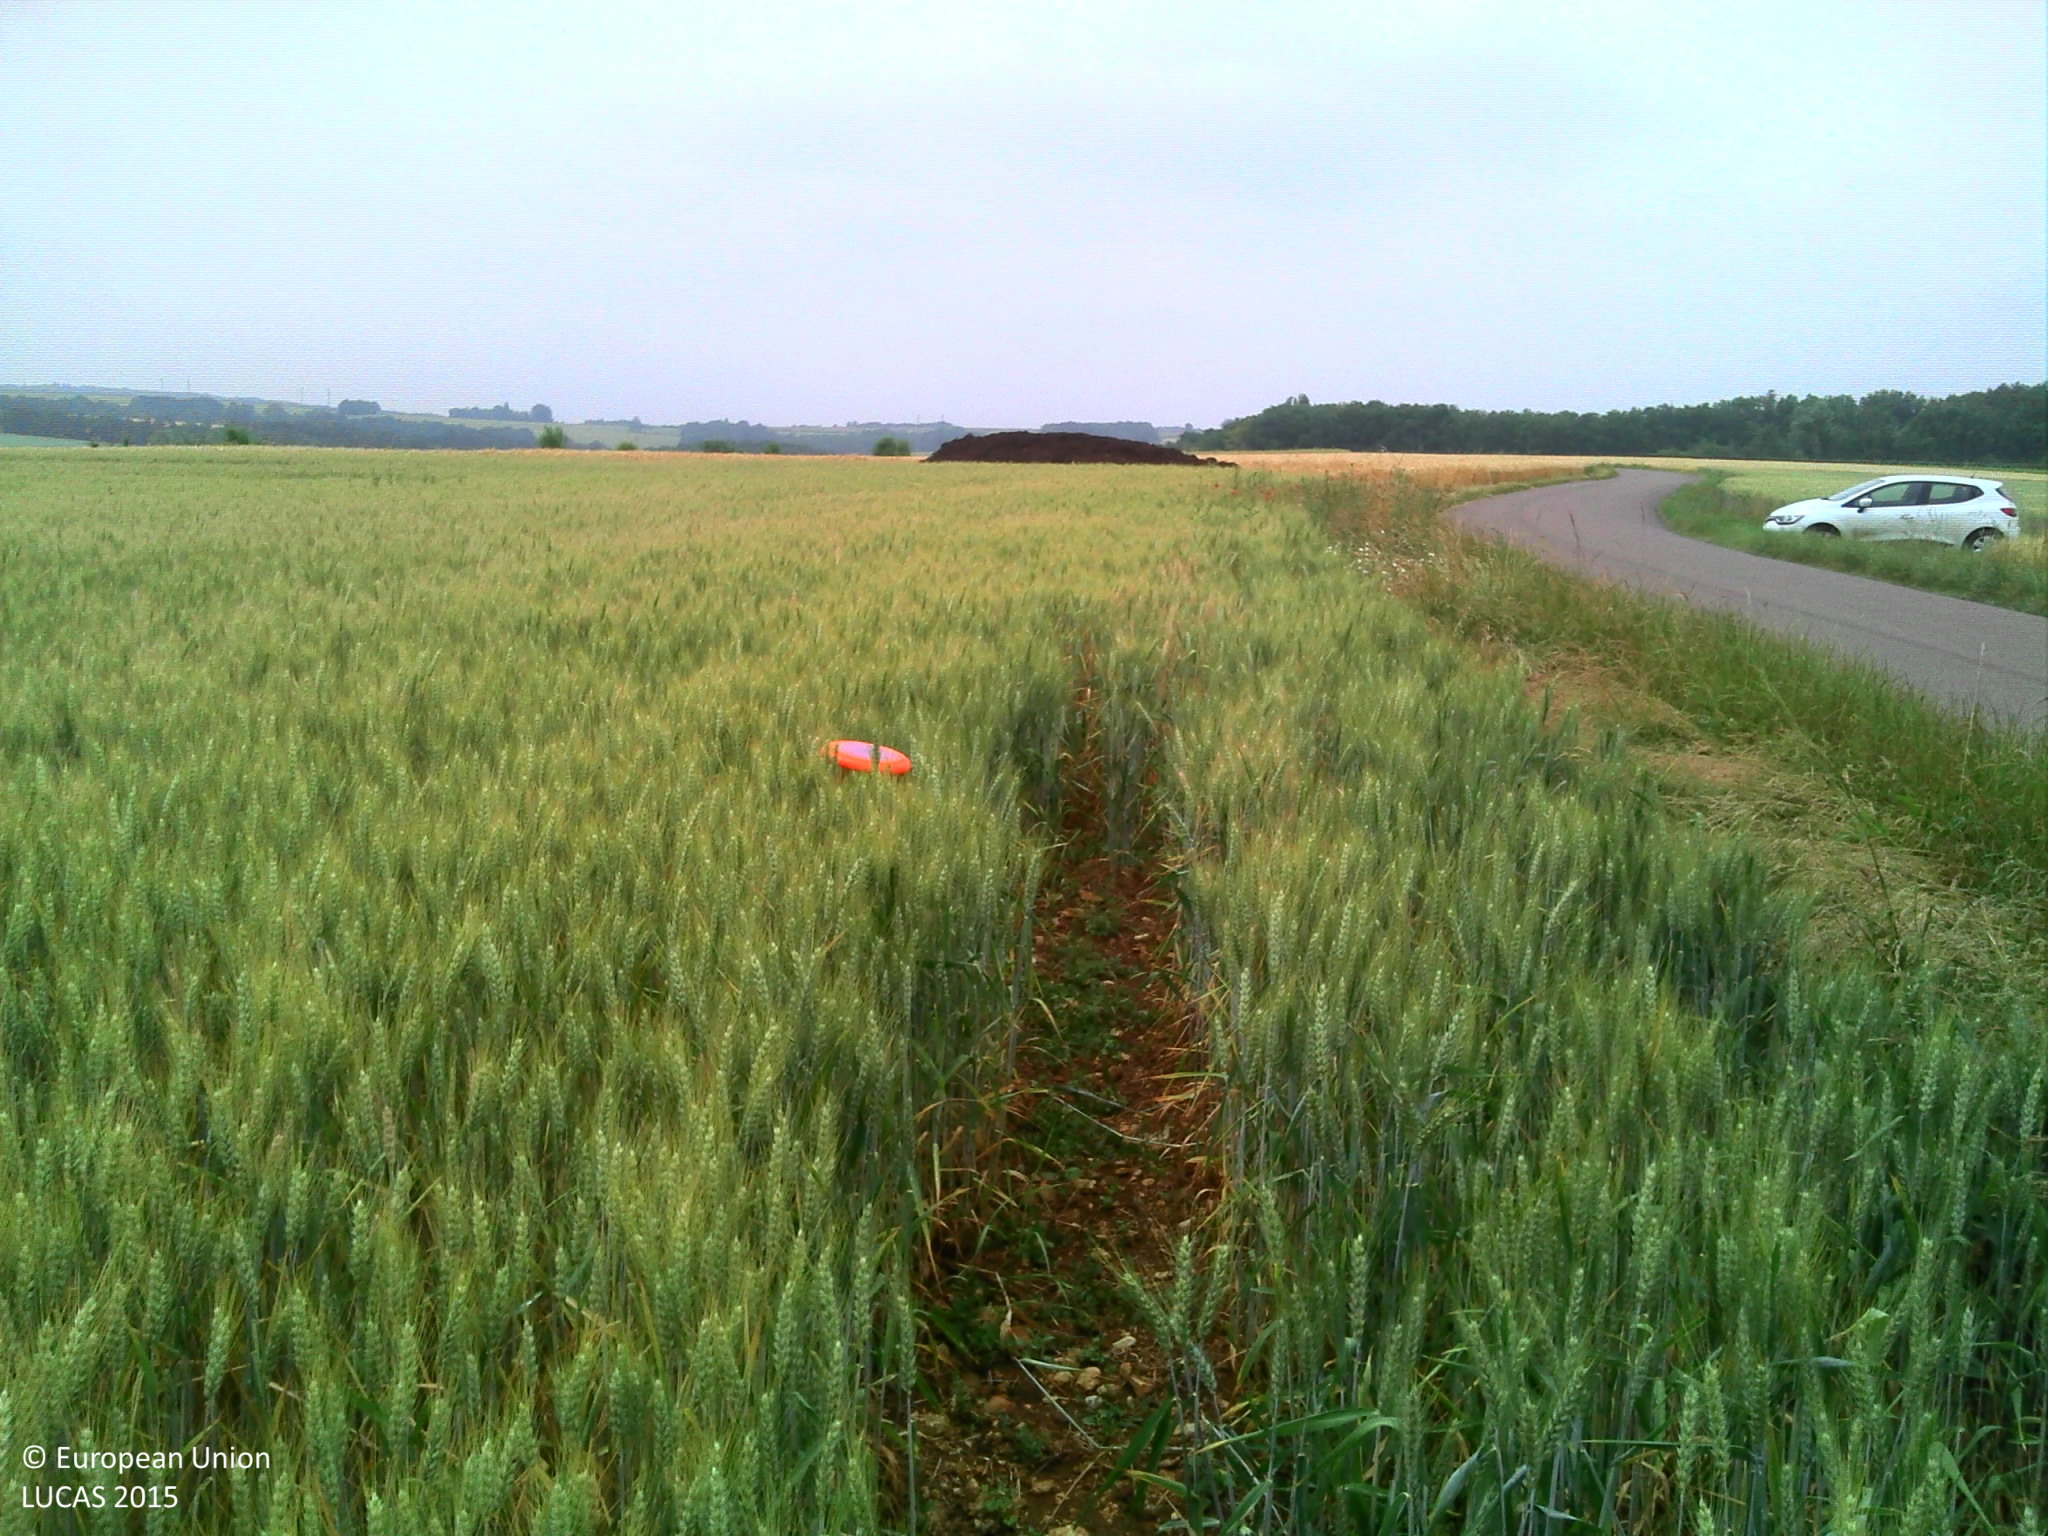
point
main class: Cropland
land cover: Common wheat
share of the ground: > 75 %
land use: Agriculture (excluding fallow land and kitchen gardens)
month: June
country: FR
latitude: 47.9108
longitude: 3.9089
